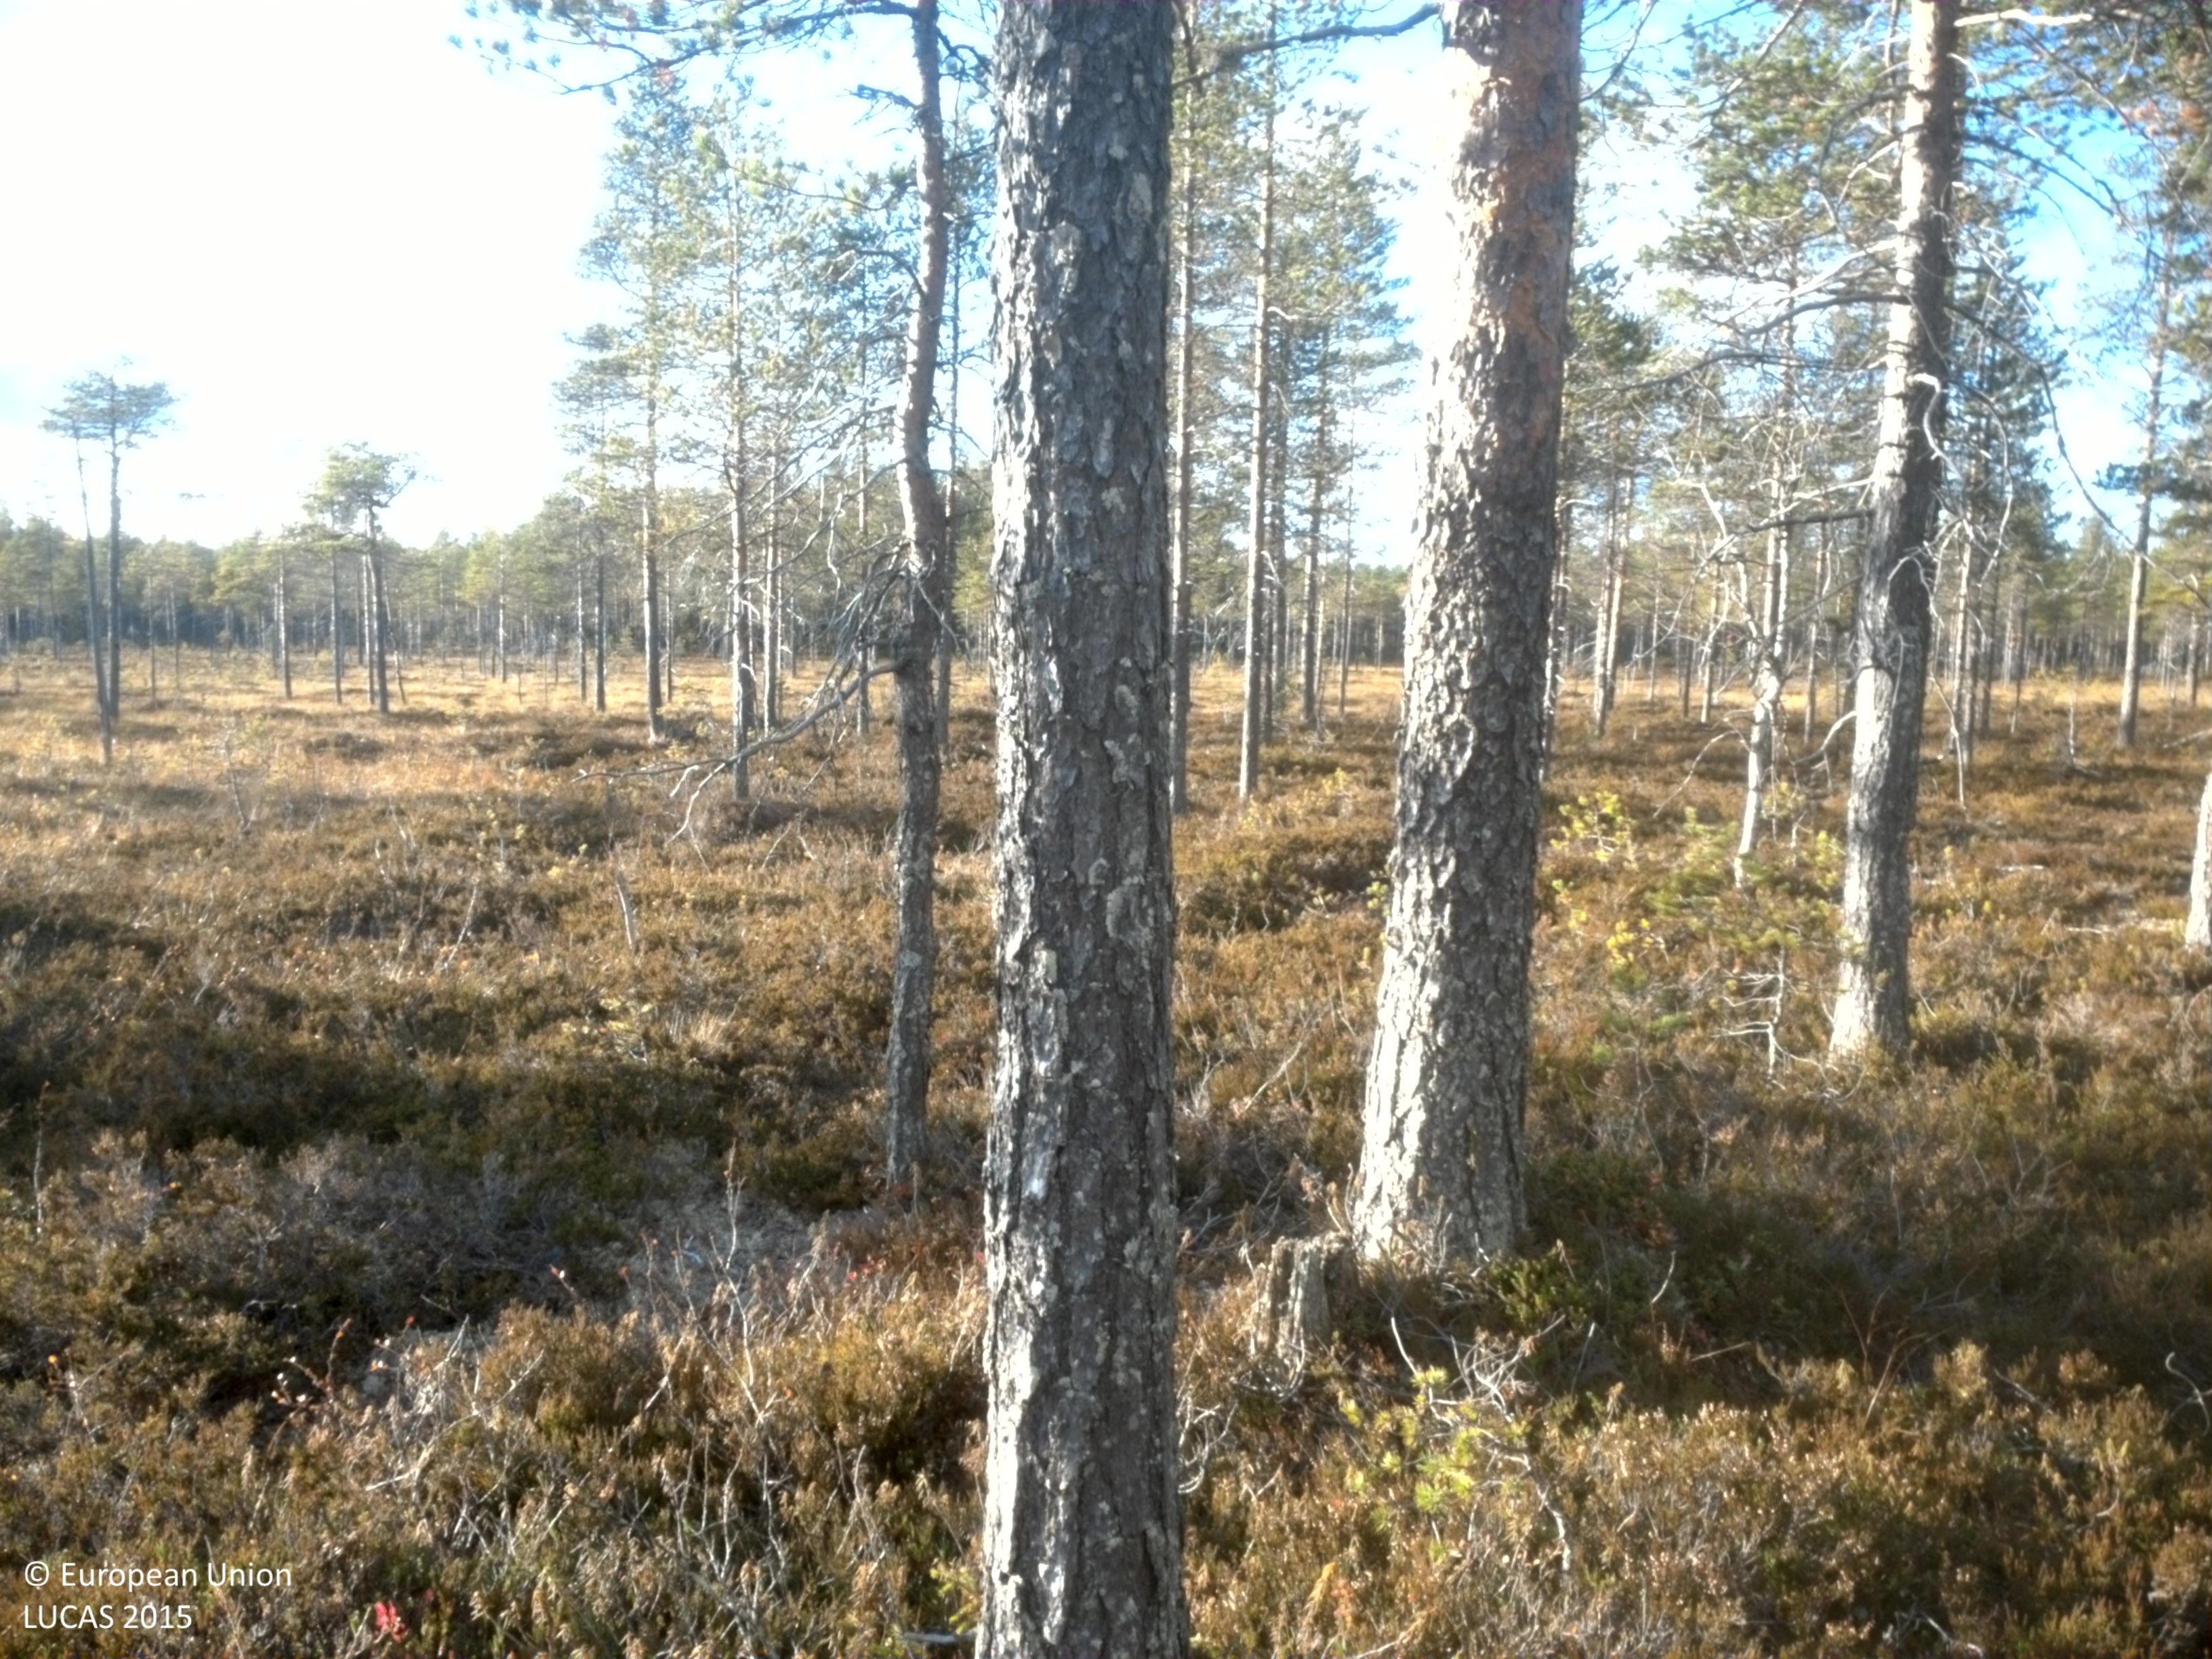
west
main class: Woodland
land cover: Pine dominated coniferous woodland
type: boreal forest
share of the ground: 25 - 50 %
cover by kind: shrubs 50 %, coniferous forest trees 40 %, lichens and mosses 10 %
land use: Forestry
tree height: > 5 m
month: September
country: SE
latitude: 64.2164
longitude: 20.1773
